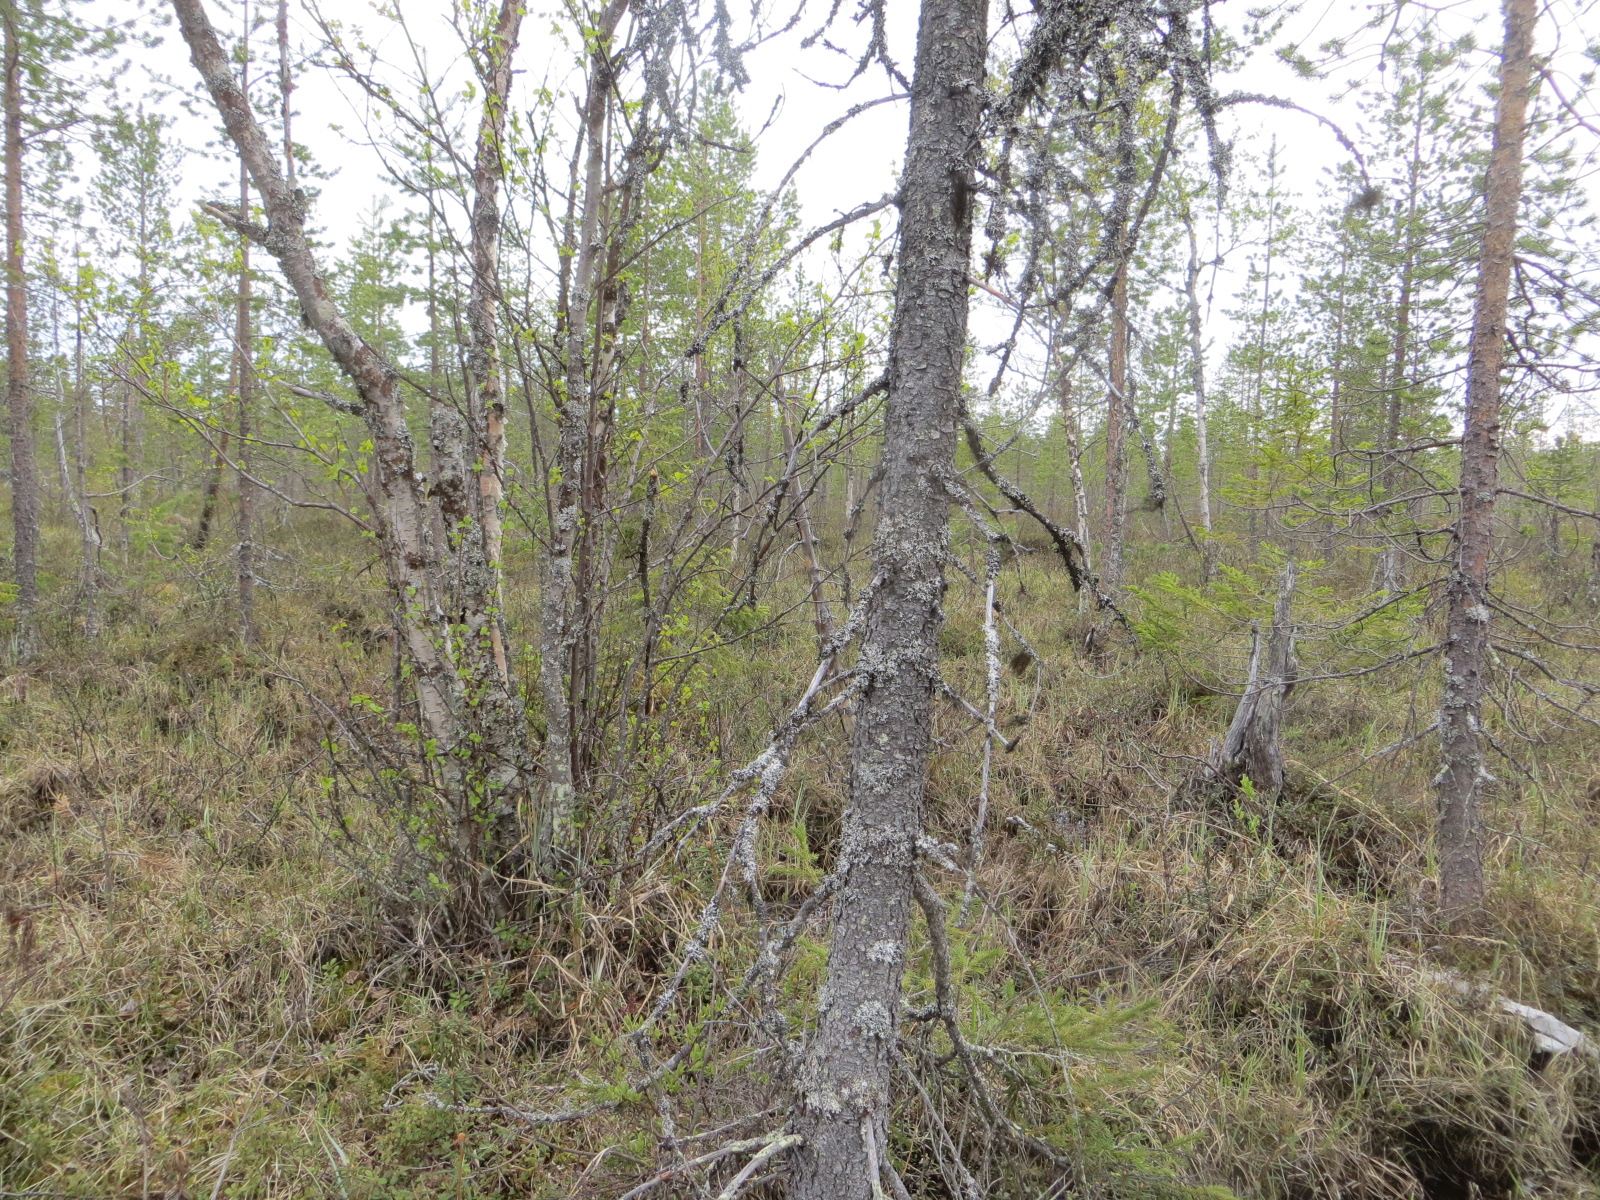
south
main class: Woodland
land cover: Pine dominated mixed woodland
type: mire and swamp forests
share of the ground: > 75 %
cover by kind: coniferous forest trees 55 %, broadleaved forest trees 25 %, shrubs 10 %, herbaceous plants 10 %
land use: Semi-natural and natural areas not in use
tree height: > 5 m
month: June
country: FI
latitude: 67.7401
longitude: 25.1065
